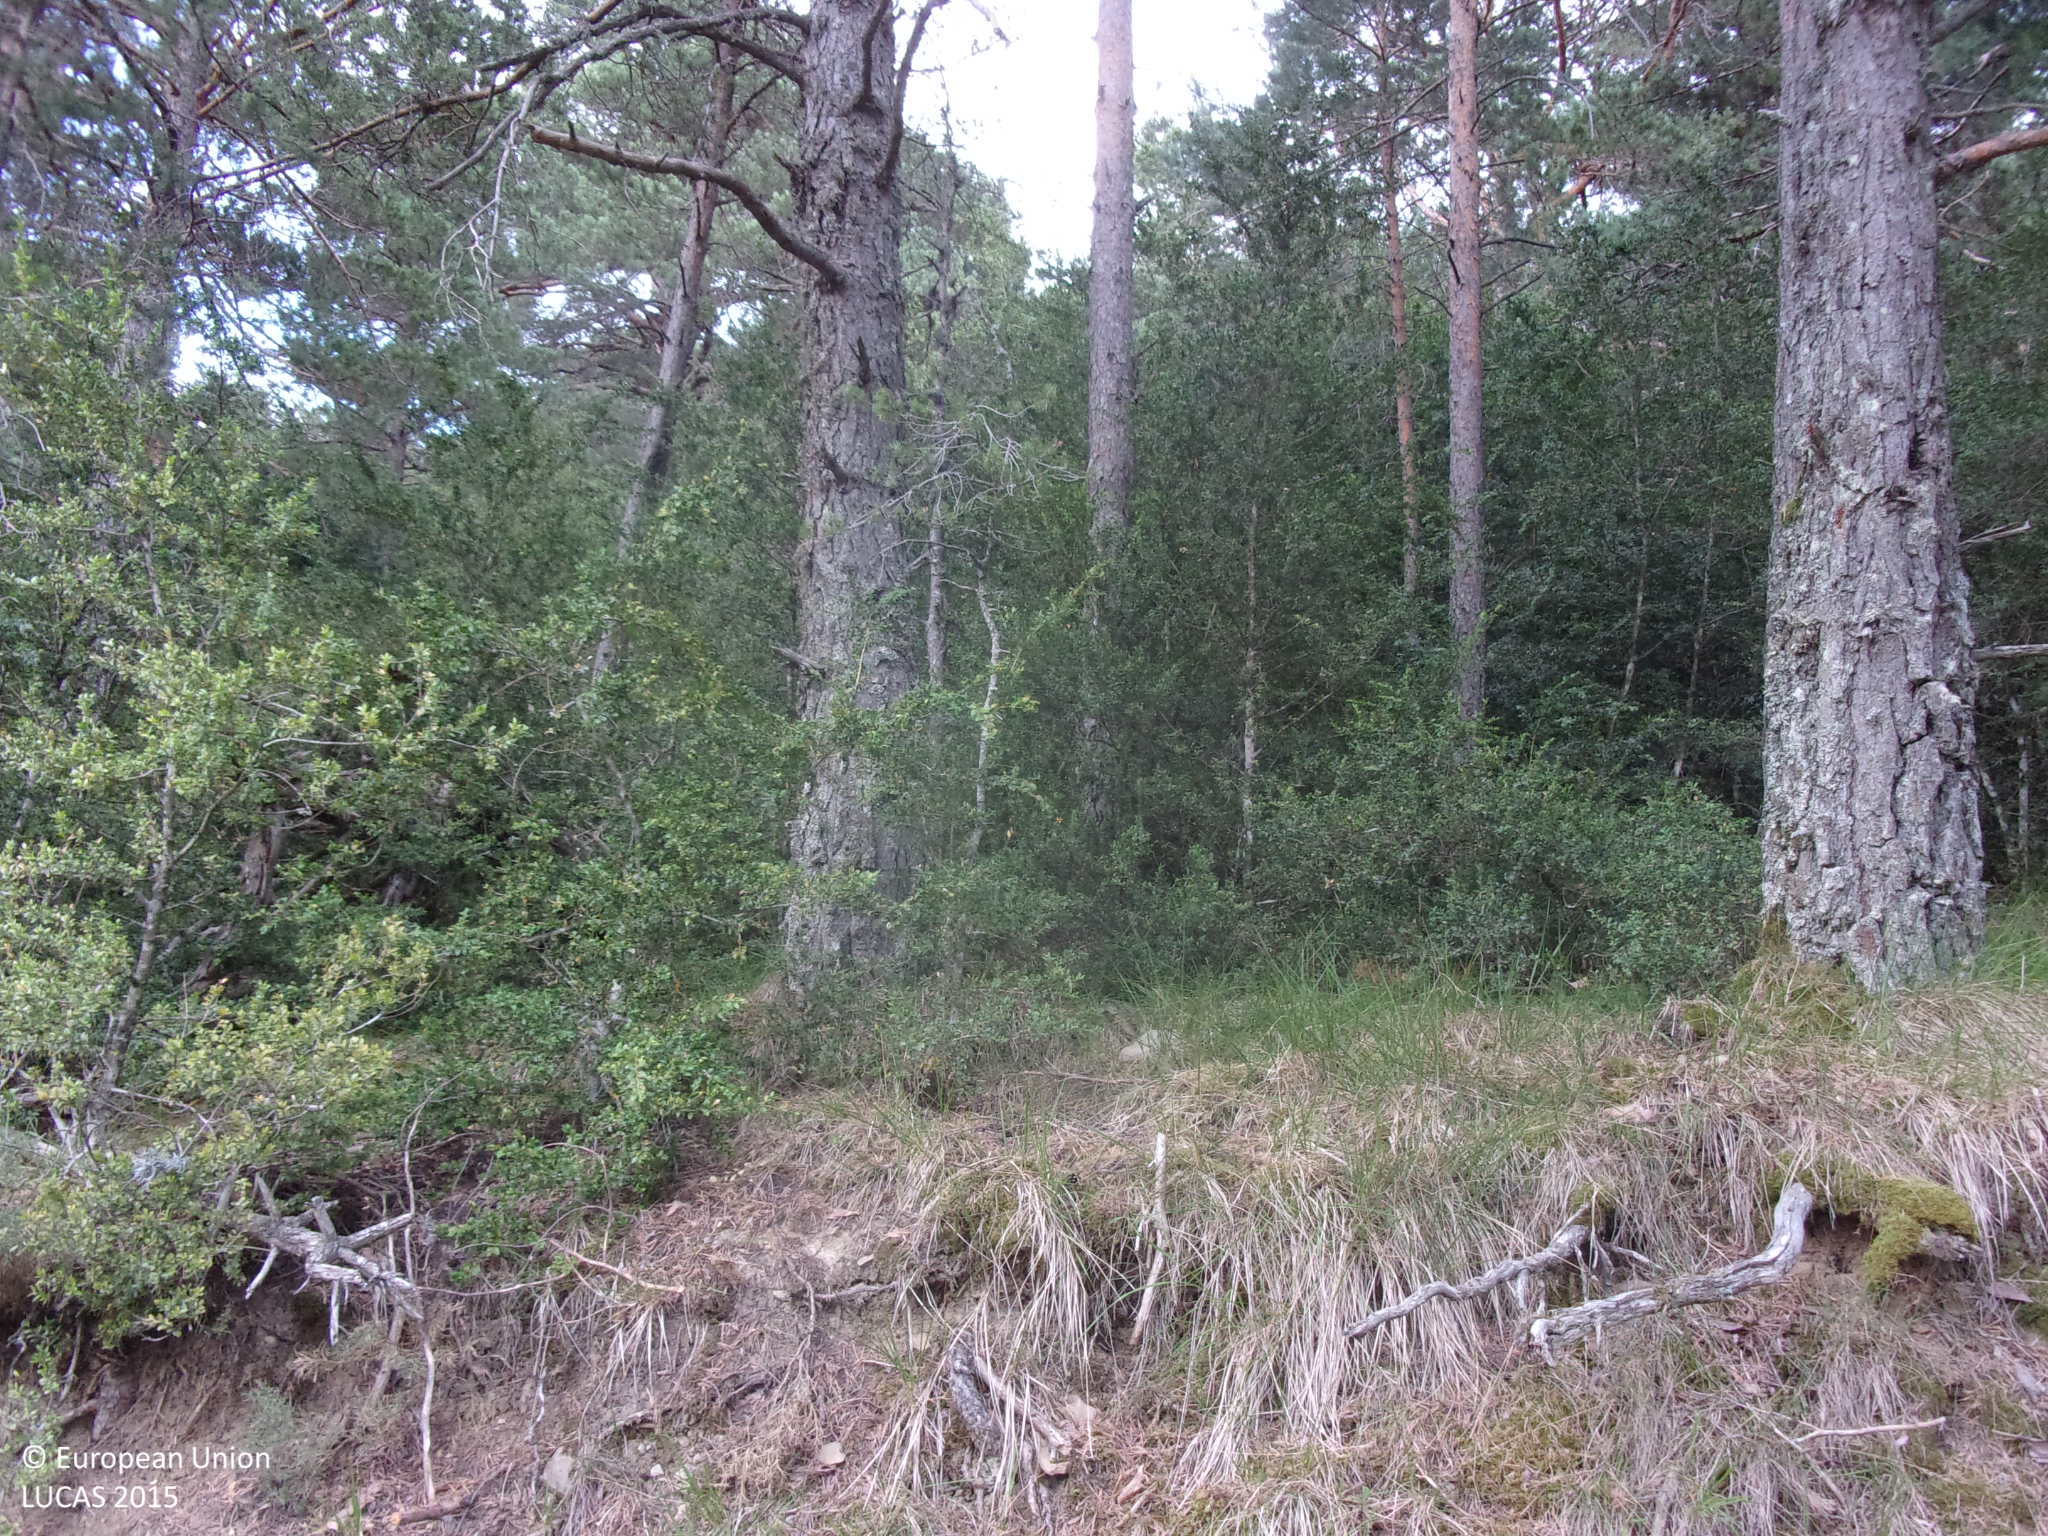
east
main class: Woodland
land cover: Pine dominated coniferous woodland
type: coniferous forest of the mediterranean region
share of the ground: > 75 %
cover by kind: coniferous forest trees 100 %
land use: Forestry
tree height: > 5 m
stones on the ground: 10 - 25 %
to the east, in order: Pine dominated coniferous woodland; Tracks; Pine dominated coniferous woodland
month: August
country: ES
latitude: 42.6010
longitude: -0.4721
